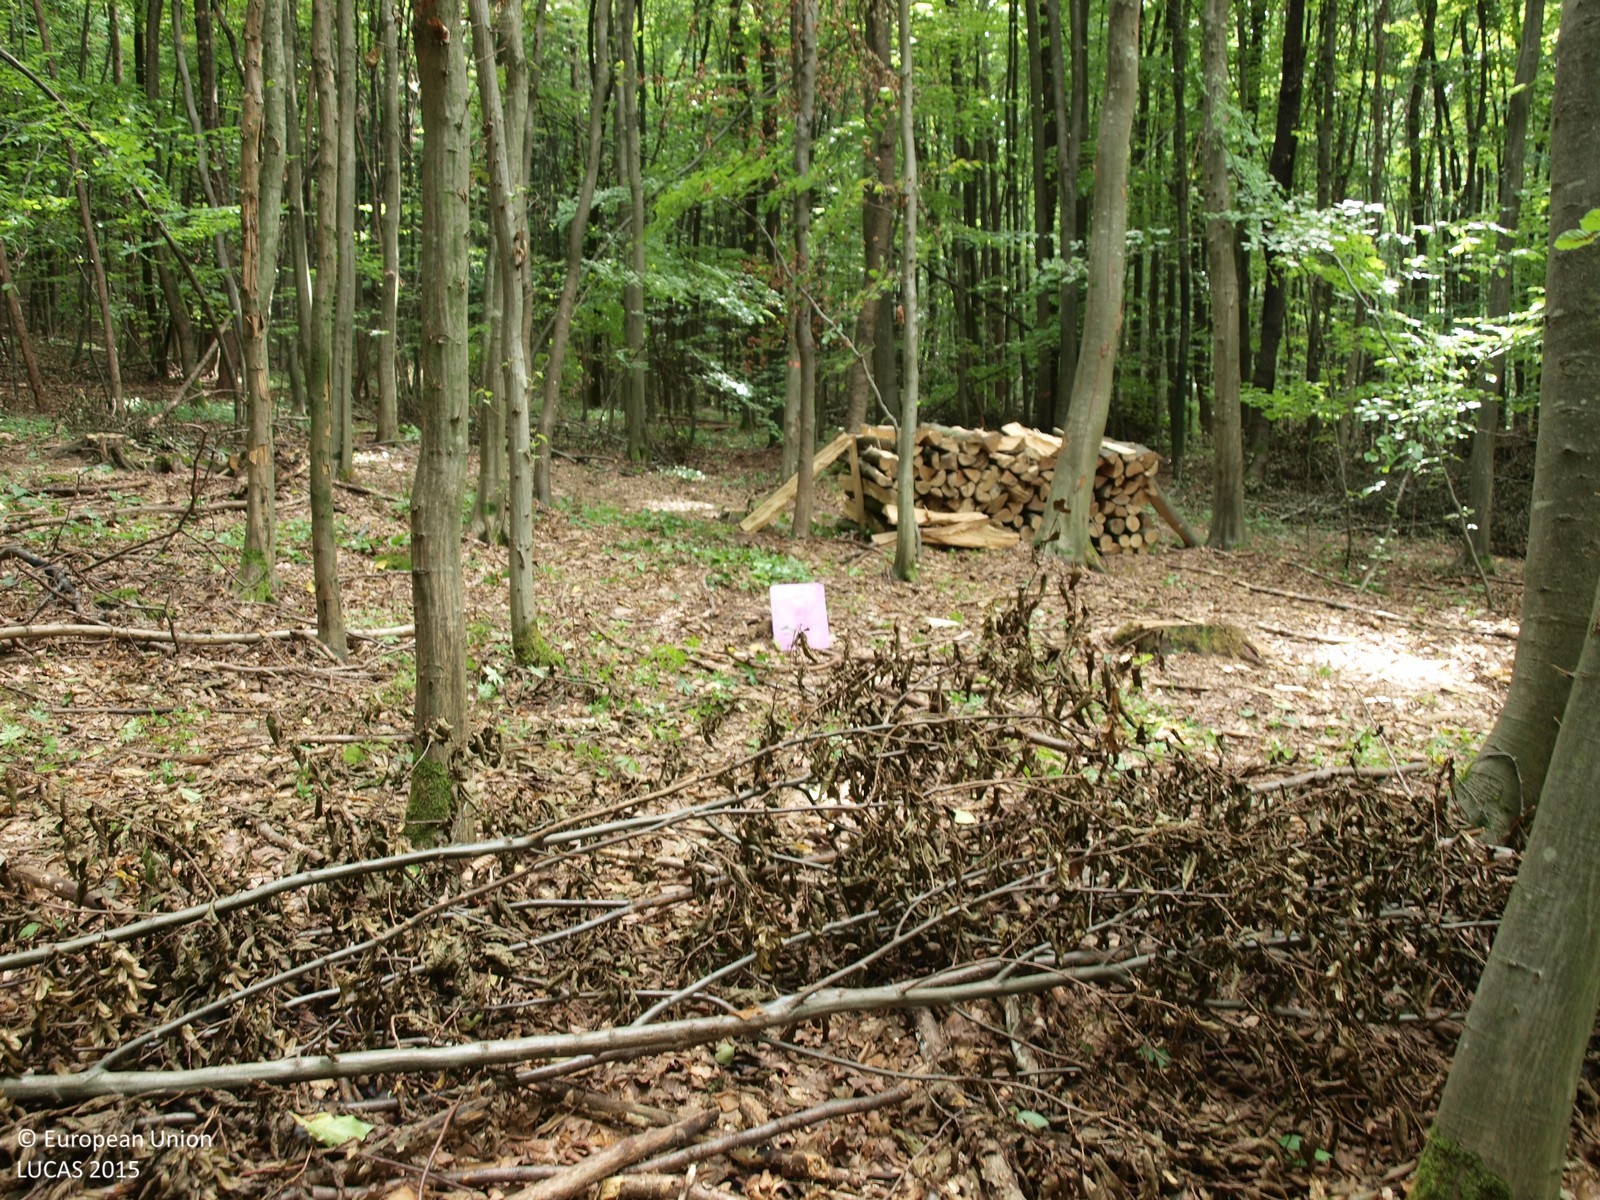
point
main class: Woodland
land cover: Broadleaved woodland
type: beech forest
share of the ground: > 75 %
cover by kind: broadleaved forest trees 100 %
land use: Forestry
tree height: > 5 m
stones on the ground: < 10 %
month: August
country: HR
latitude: 46.0028
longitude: 16.5986
